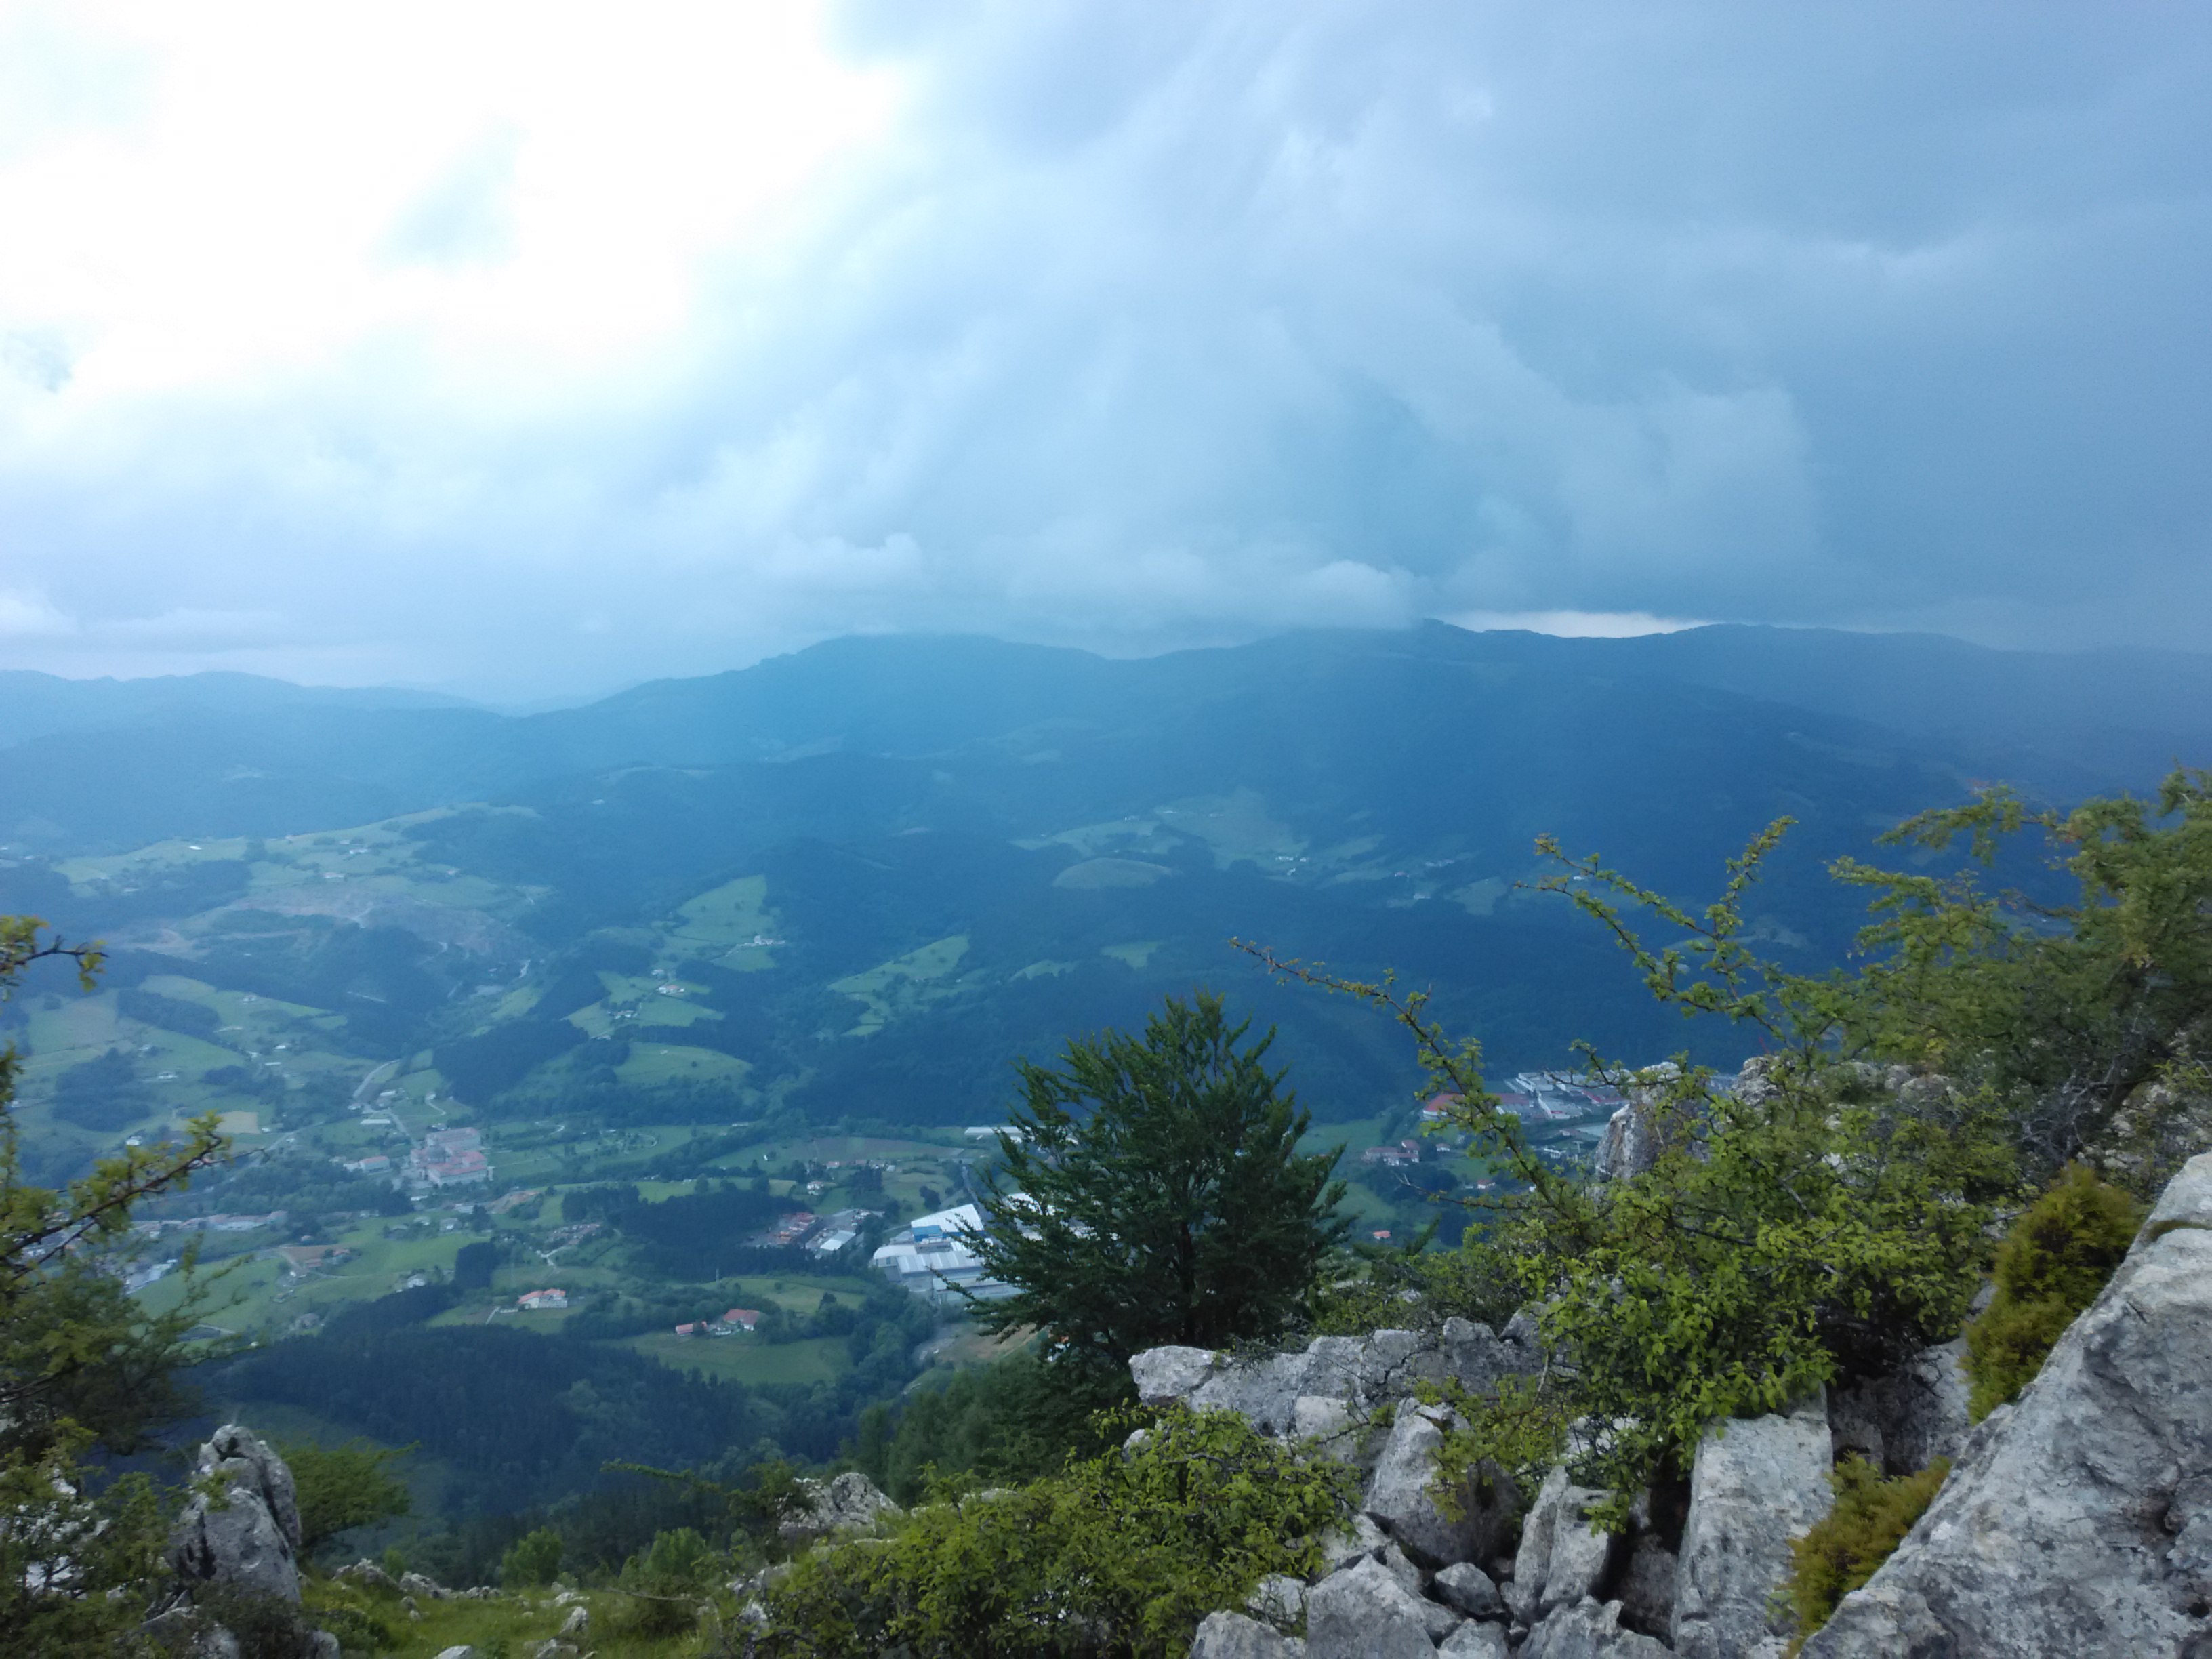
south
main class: Grassland
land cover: Grassland with sparse tree/shrub cover
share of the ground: 25 - 50 %
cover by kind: consolidated bare surface 50 %, herbaceous plants 40 %, broadleaved forest trees 5 %, shrubs 5 %
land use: Agriculture (excluding fallow land and kitchen gardens)
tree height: < 5 m
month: June
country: ES
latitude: 43.1971
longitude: -2.2944
